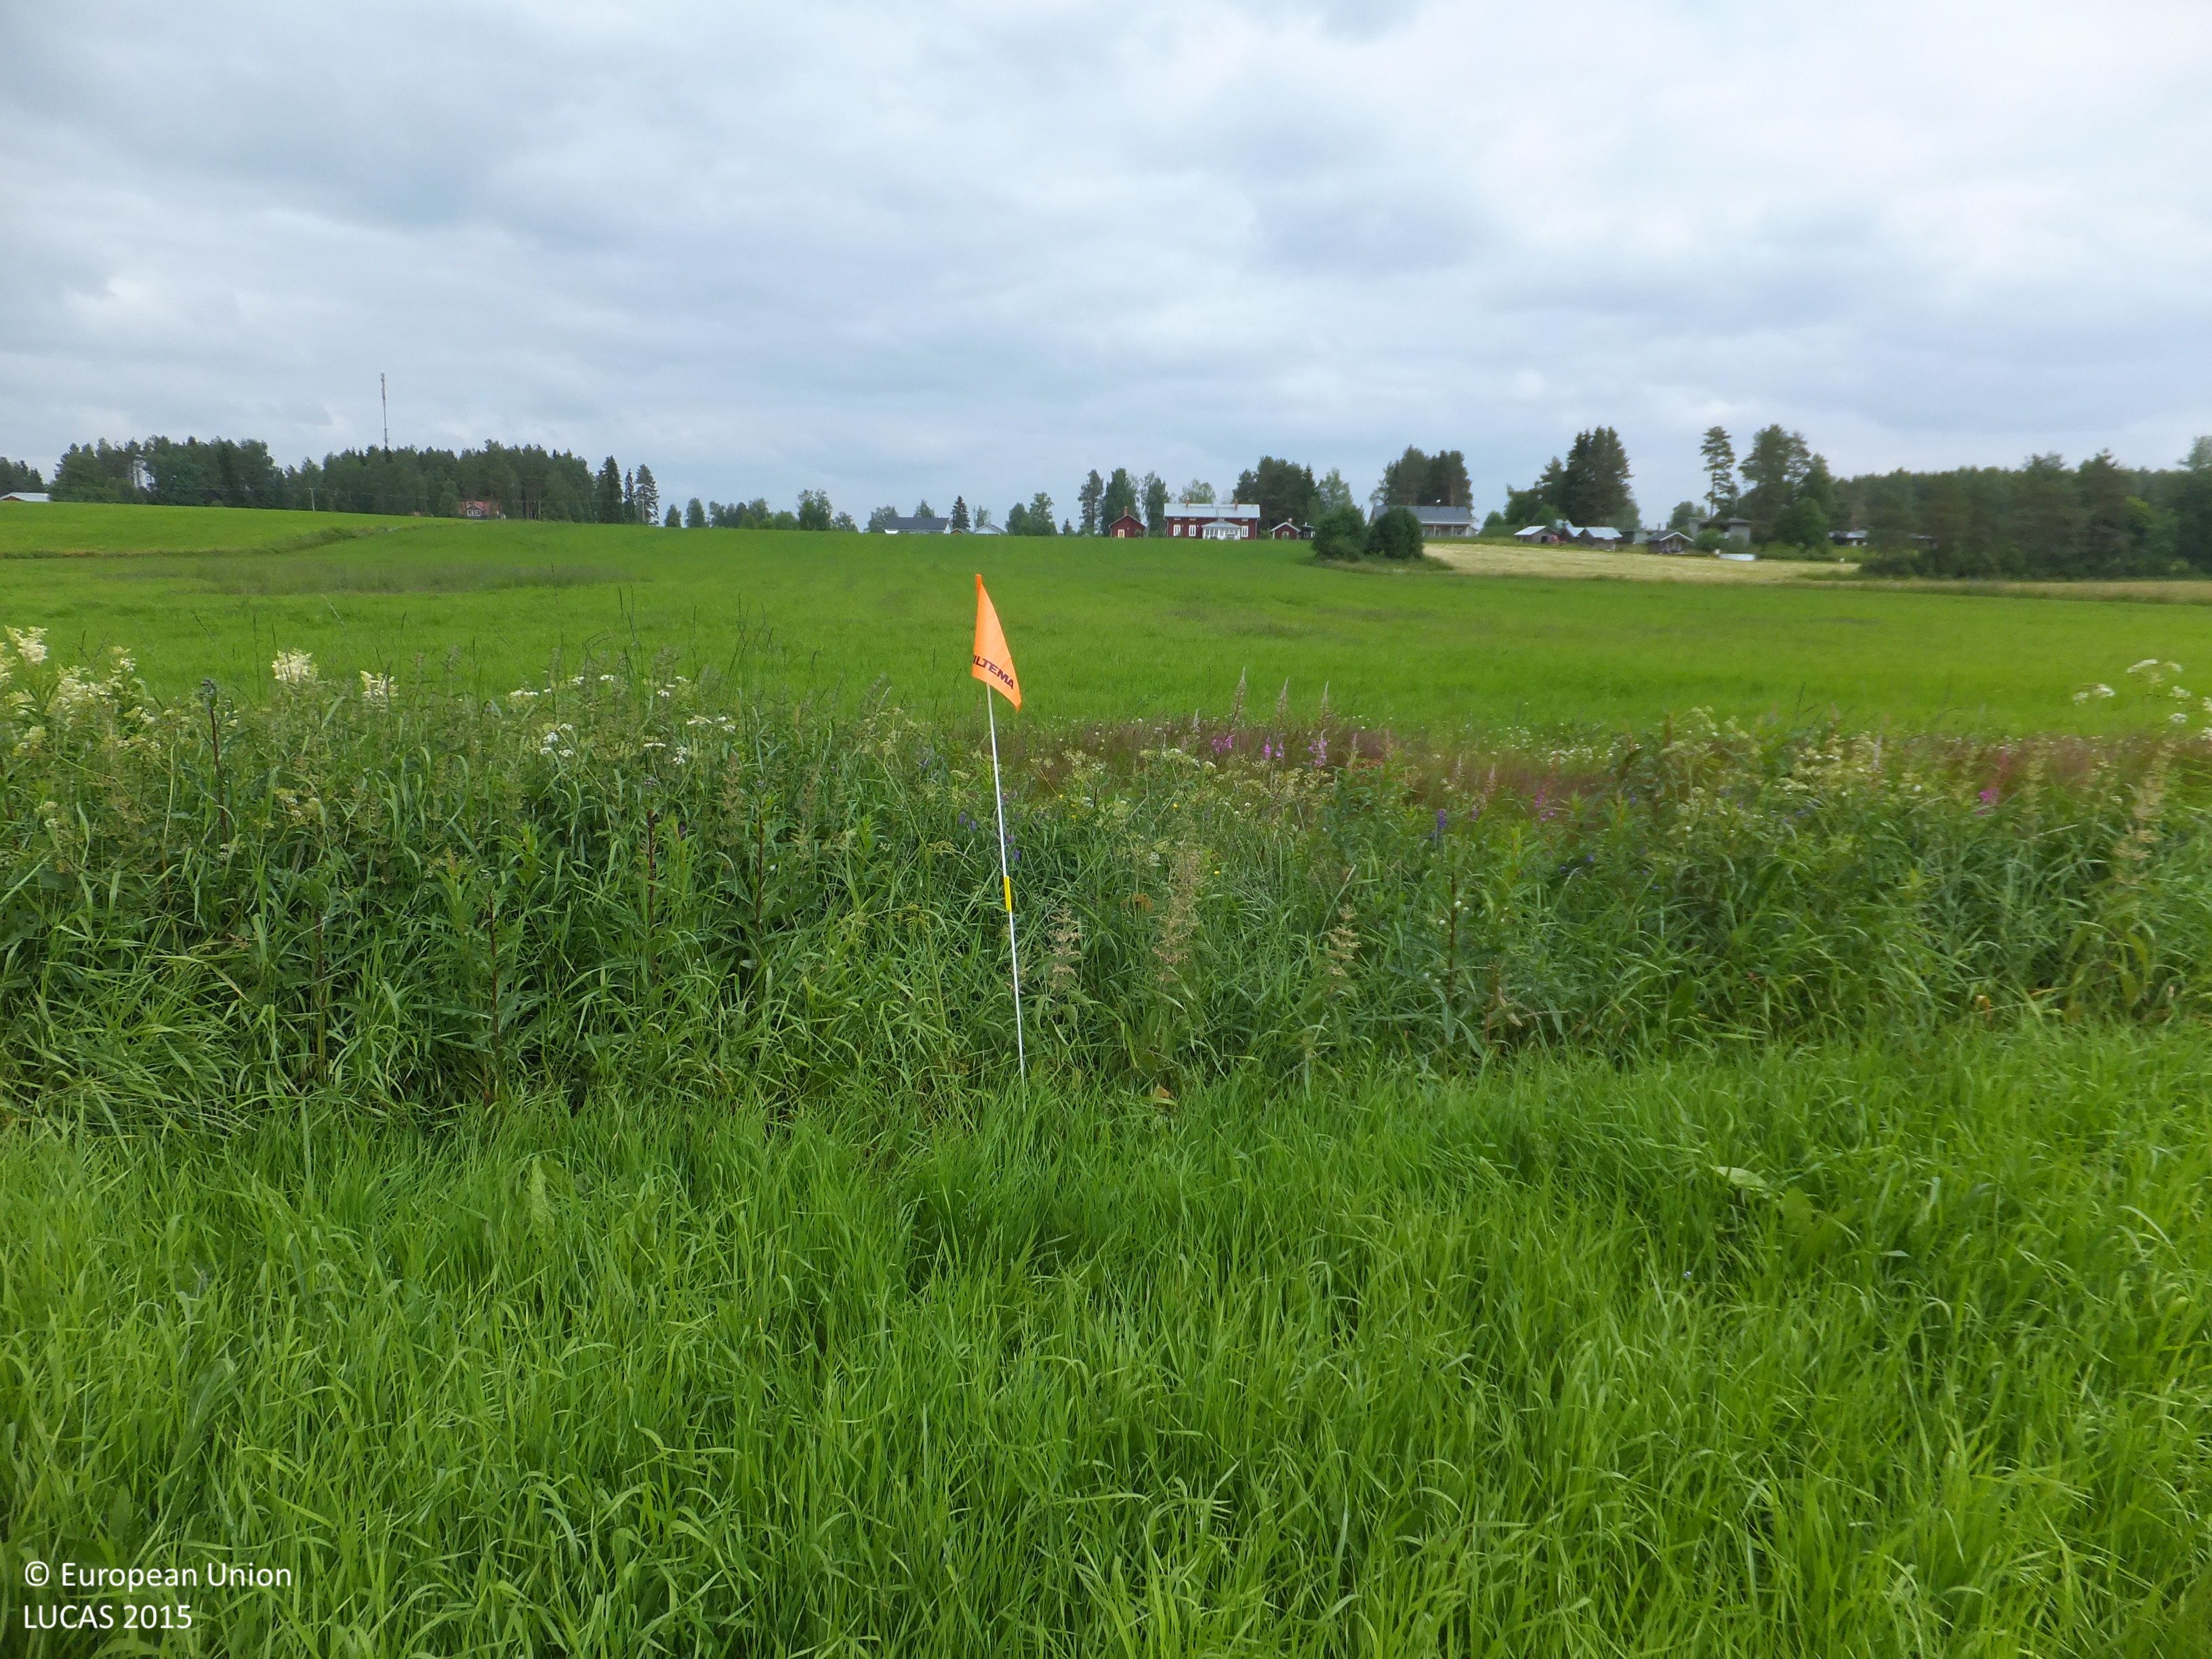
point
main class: Grassland
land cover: Grassland without tree/shrub cover
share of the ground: > 75 %
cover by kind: herbaceous plants 100 %
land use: Agriculture (excluding fallow land and kitchen gardens)
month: July
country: FI
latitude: 63.4755
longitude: 23.0000
